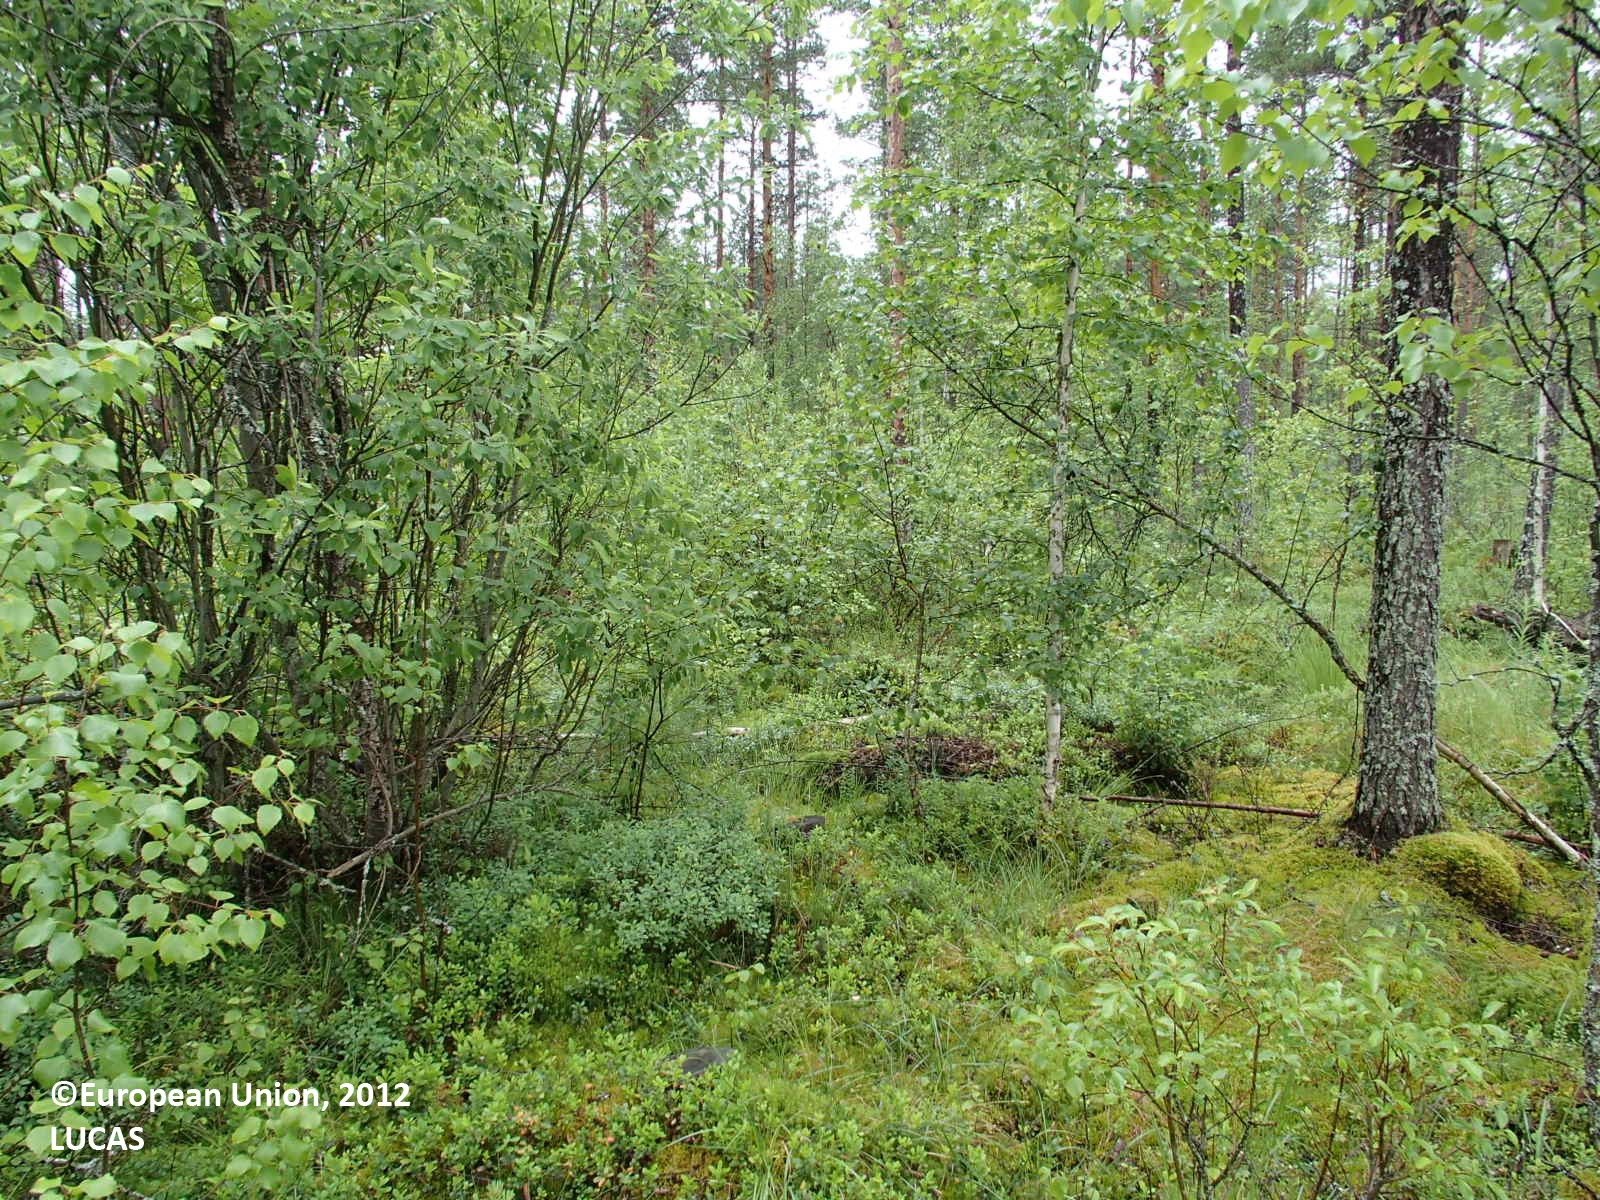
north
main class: Woodland
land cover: Pine dominated mixed woodland
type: boreal forest
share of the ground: > 75 %
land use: Forestry
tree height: > 5 m
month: July
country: FI
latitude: 64.3939
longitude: 26.3499
